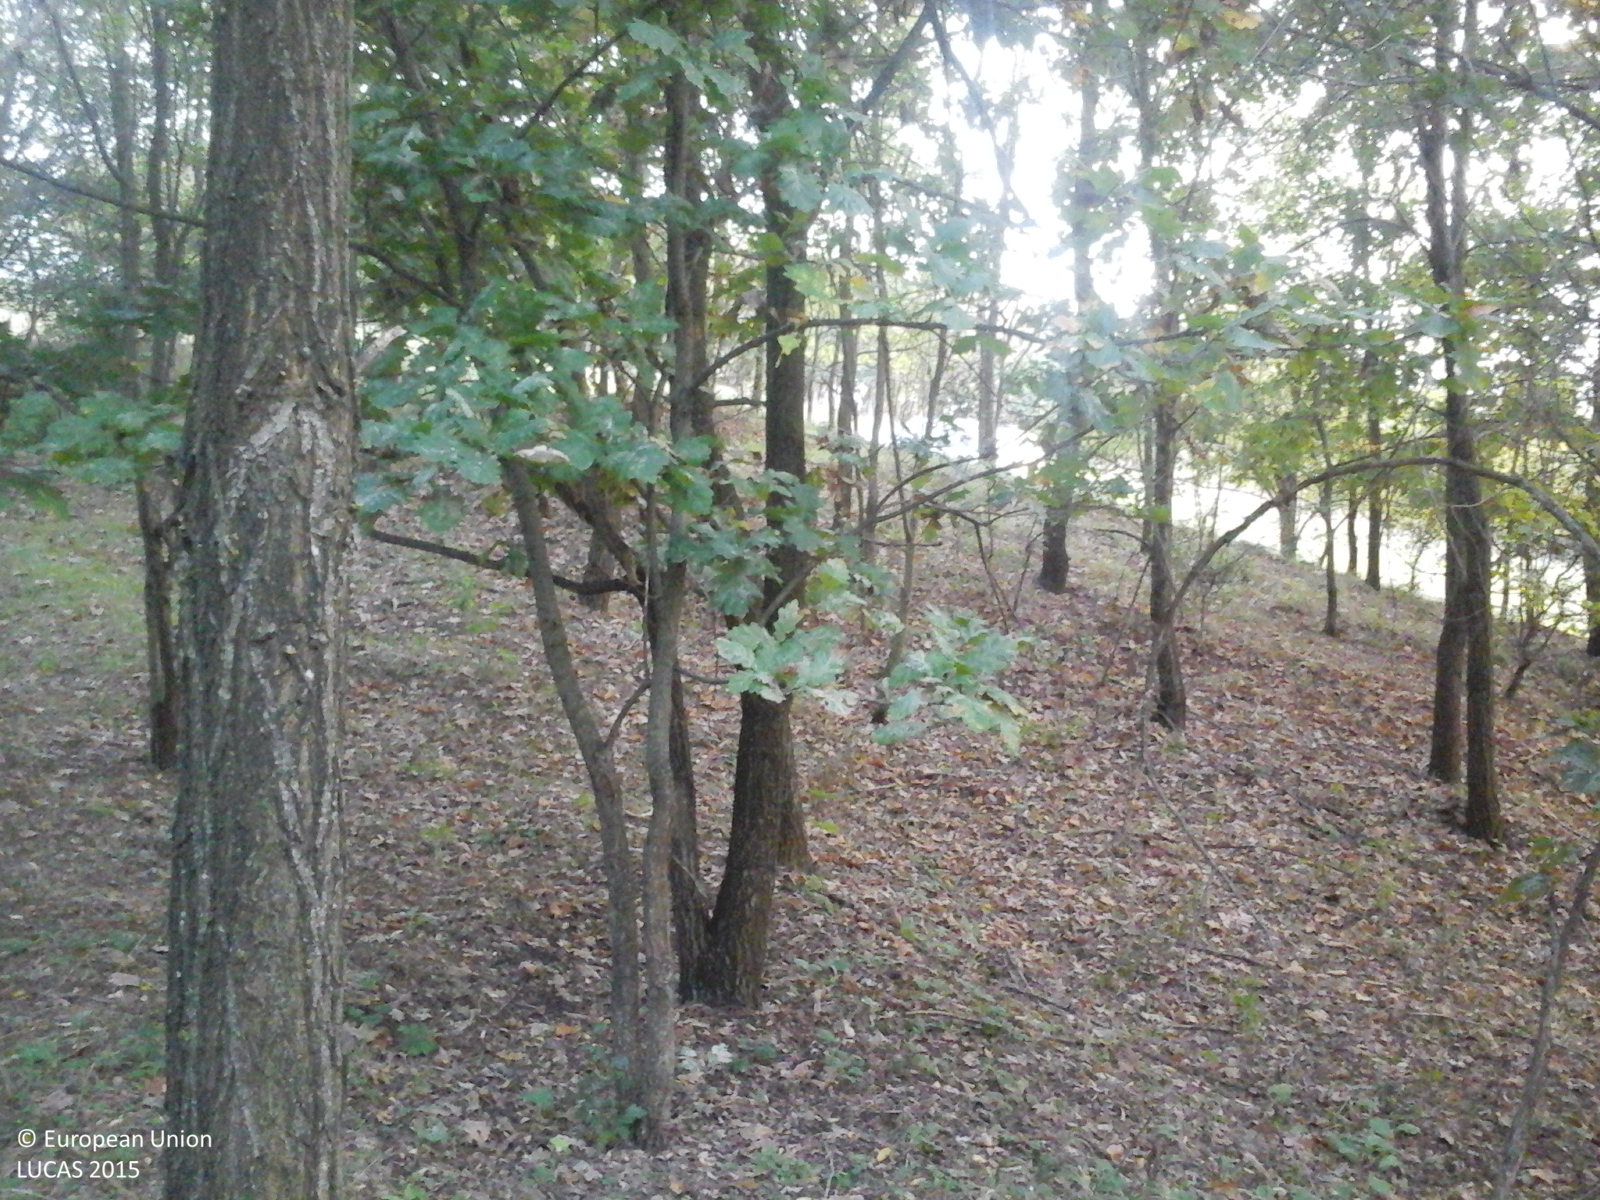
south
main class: Woodland
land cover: Broadleaved woodland
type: exotic forest
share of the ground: > 75 %
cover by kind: broadleaved forest trees 100 %
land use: Forestry
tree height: > 5 m
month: October
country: RO
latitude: 46.5304
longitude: 24.0676
